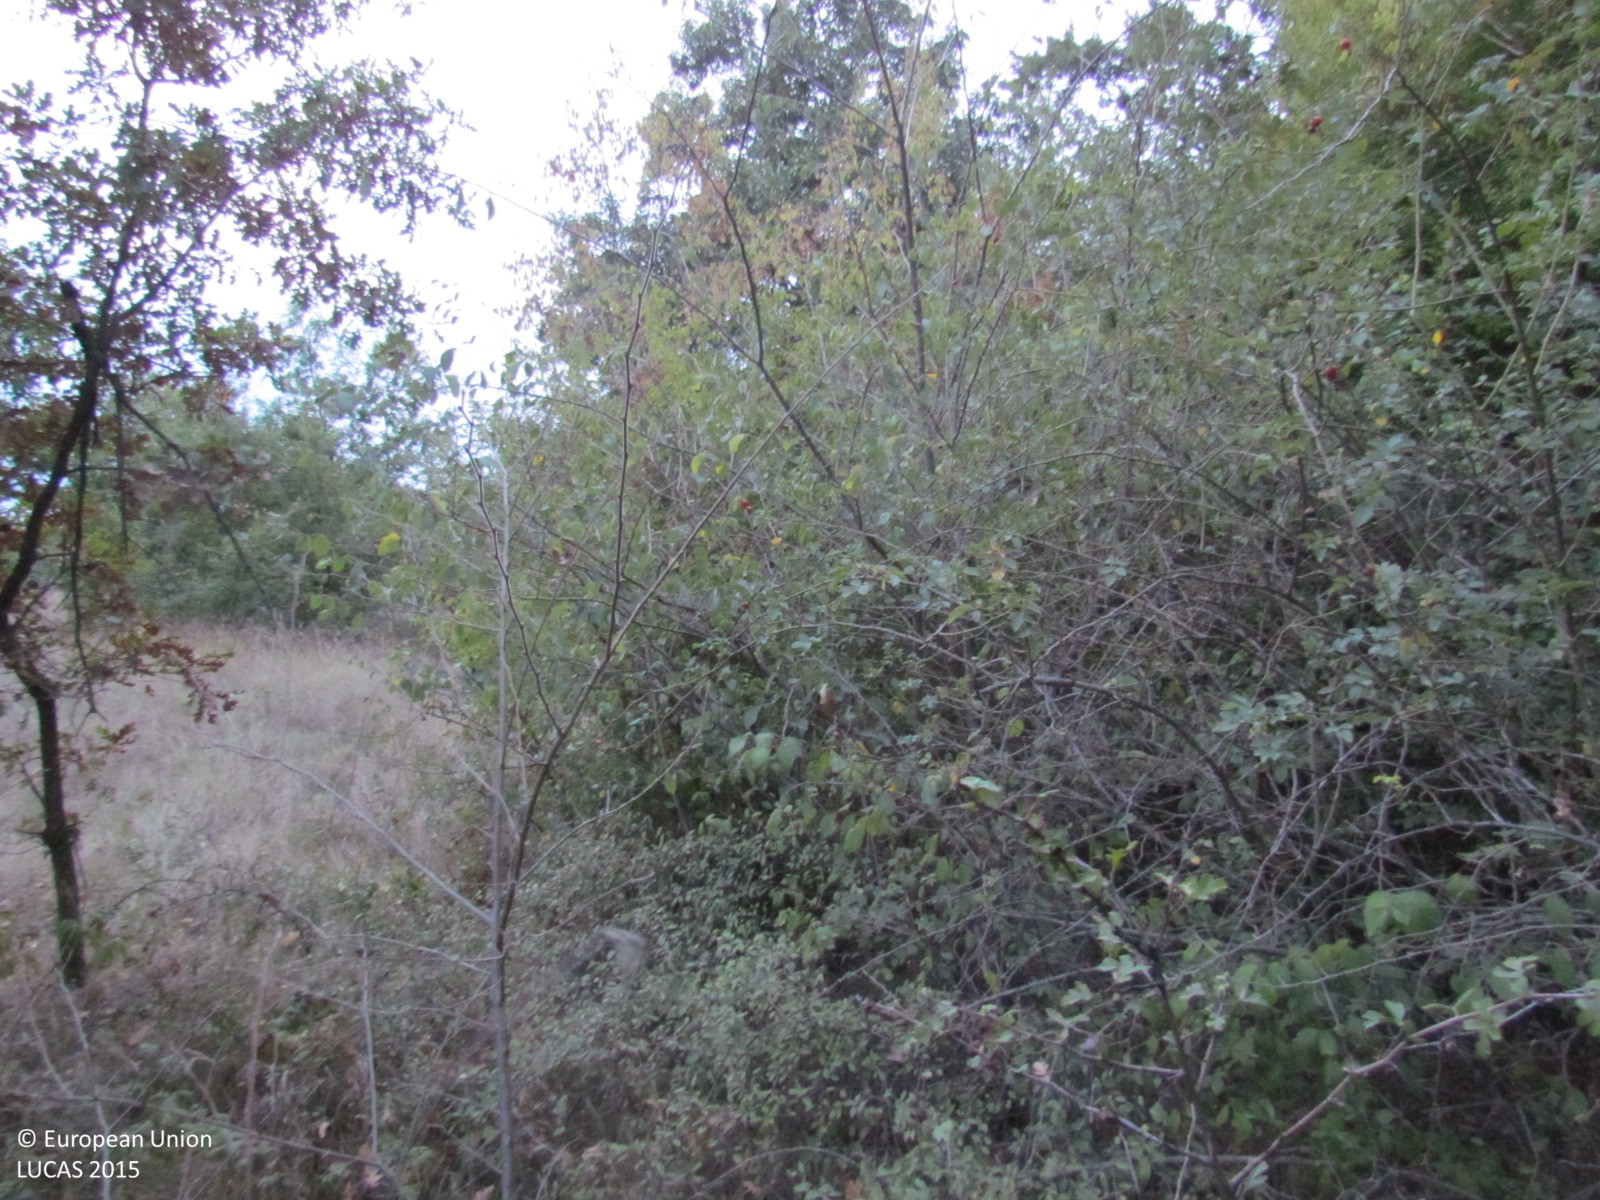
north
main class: Woodland
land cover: Broadleaved woodland
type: acidophilous oak and oak-birch forest
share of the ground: > 75 %
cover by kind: broadleaved forest trees 80 %, shrubs 10 %, herbaceous plants 10 %
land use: Forestry
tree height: > 5 m
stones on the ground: < 10 %
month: October
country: BG
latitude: 42.6989
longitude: 26.7643
